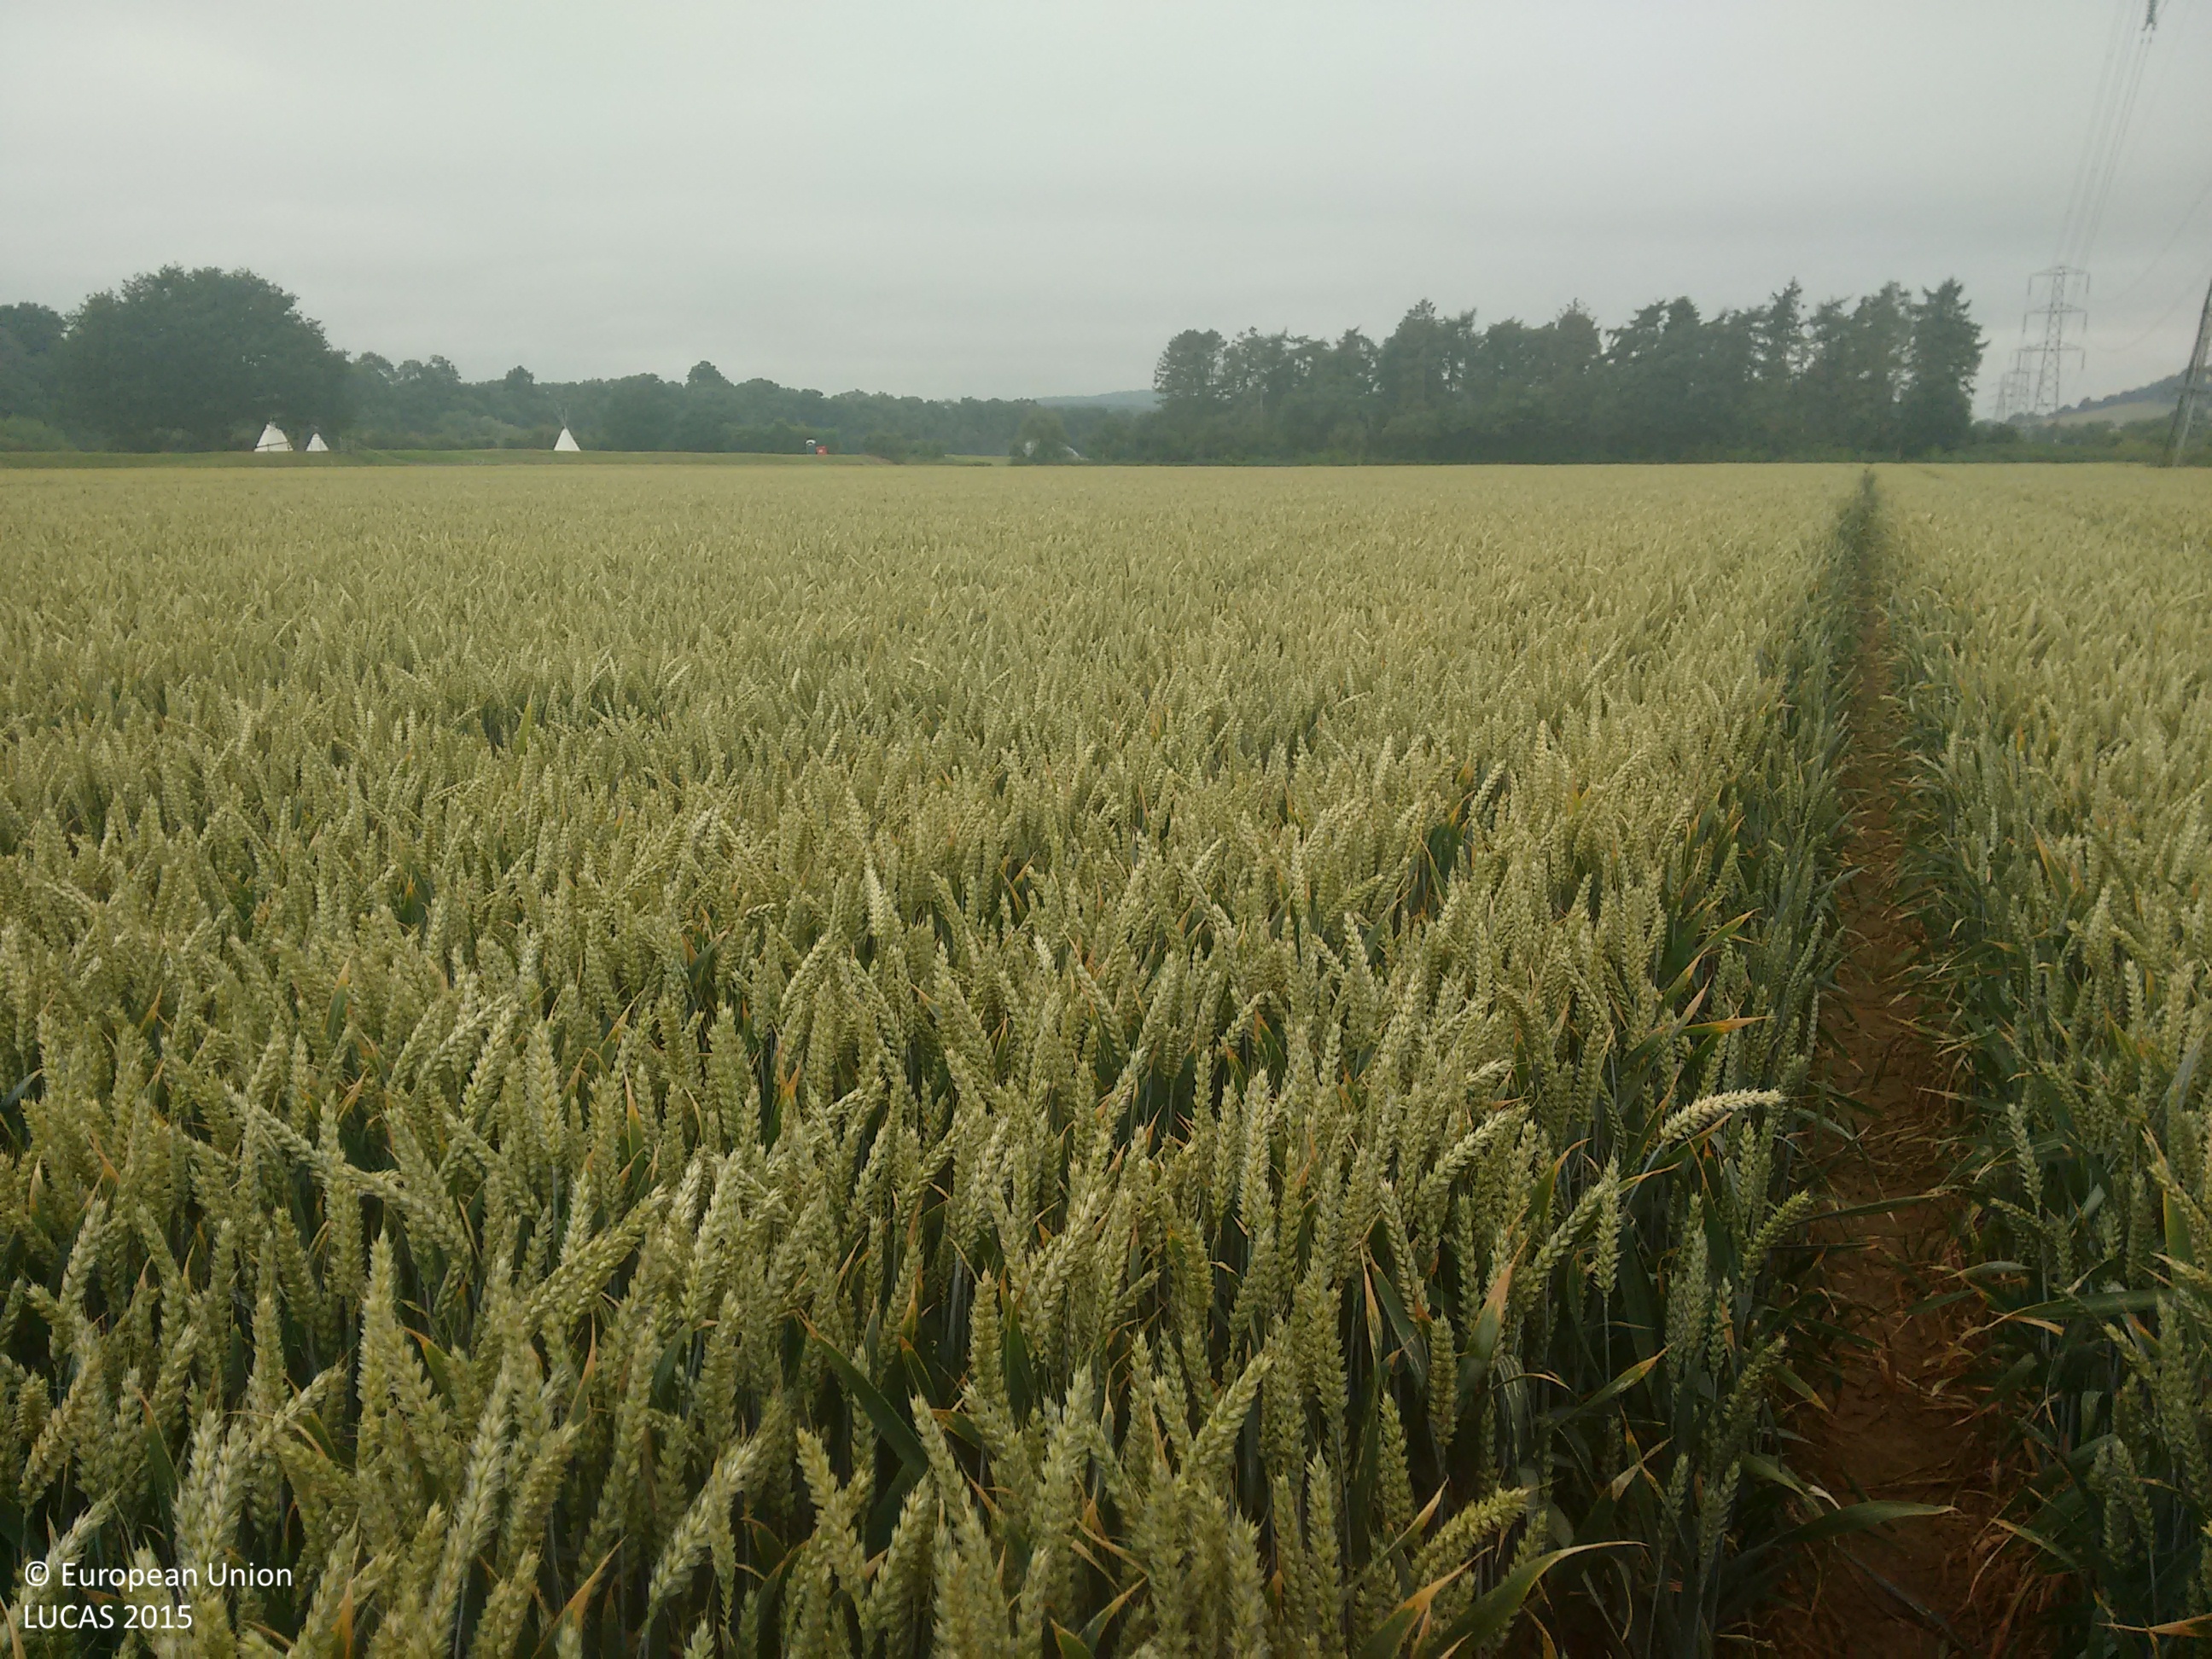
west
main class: Cropland
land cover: Common wheat
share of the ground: > 75 %
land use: Agriculture (excluding fallow land and kitchen gardens)
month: July
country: GB
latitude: 52.0254
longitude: -2.6464
